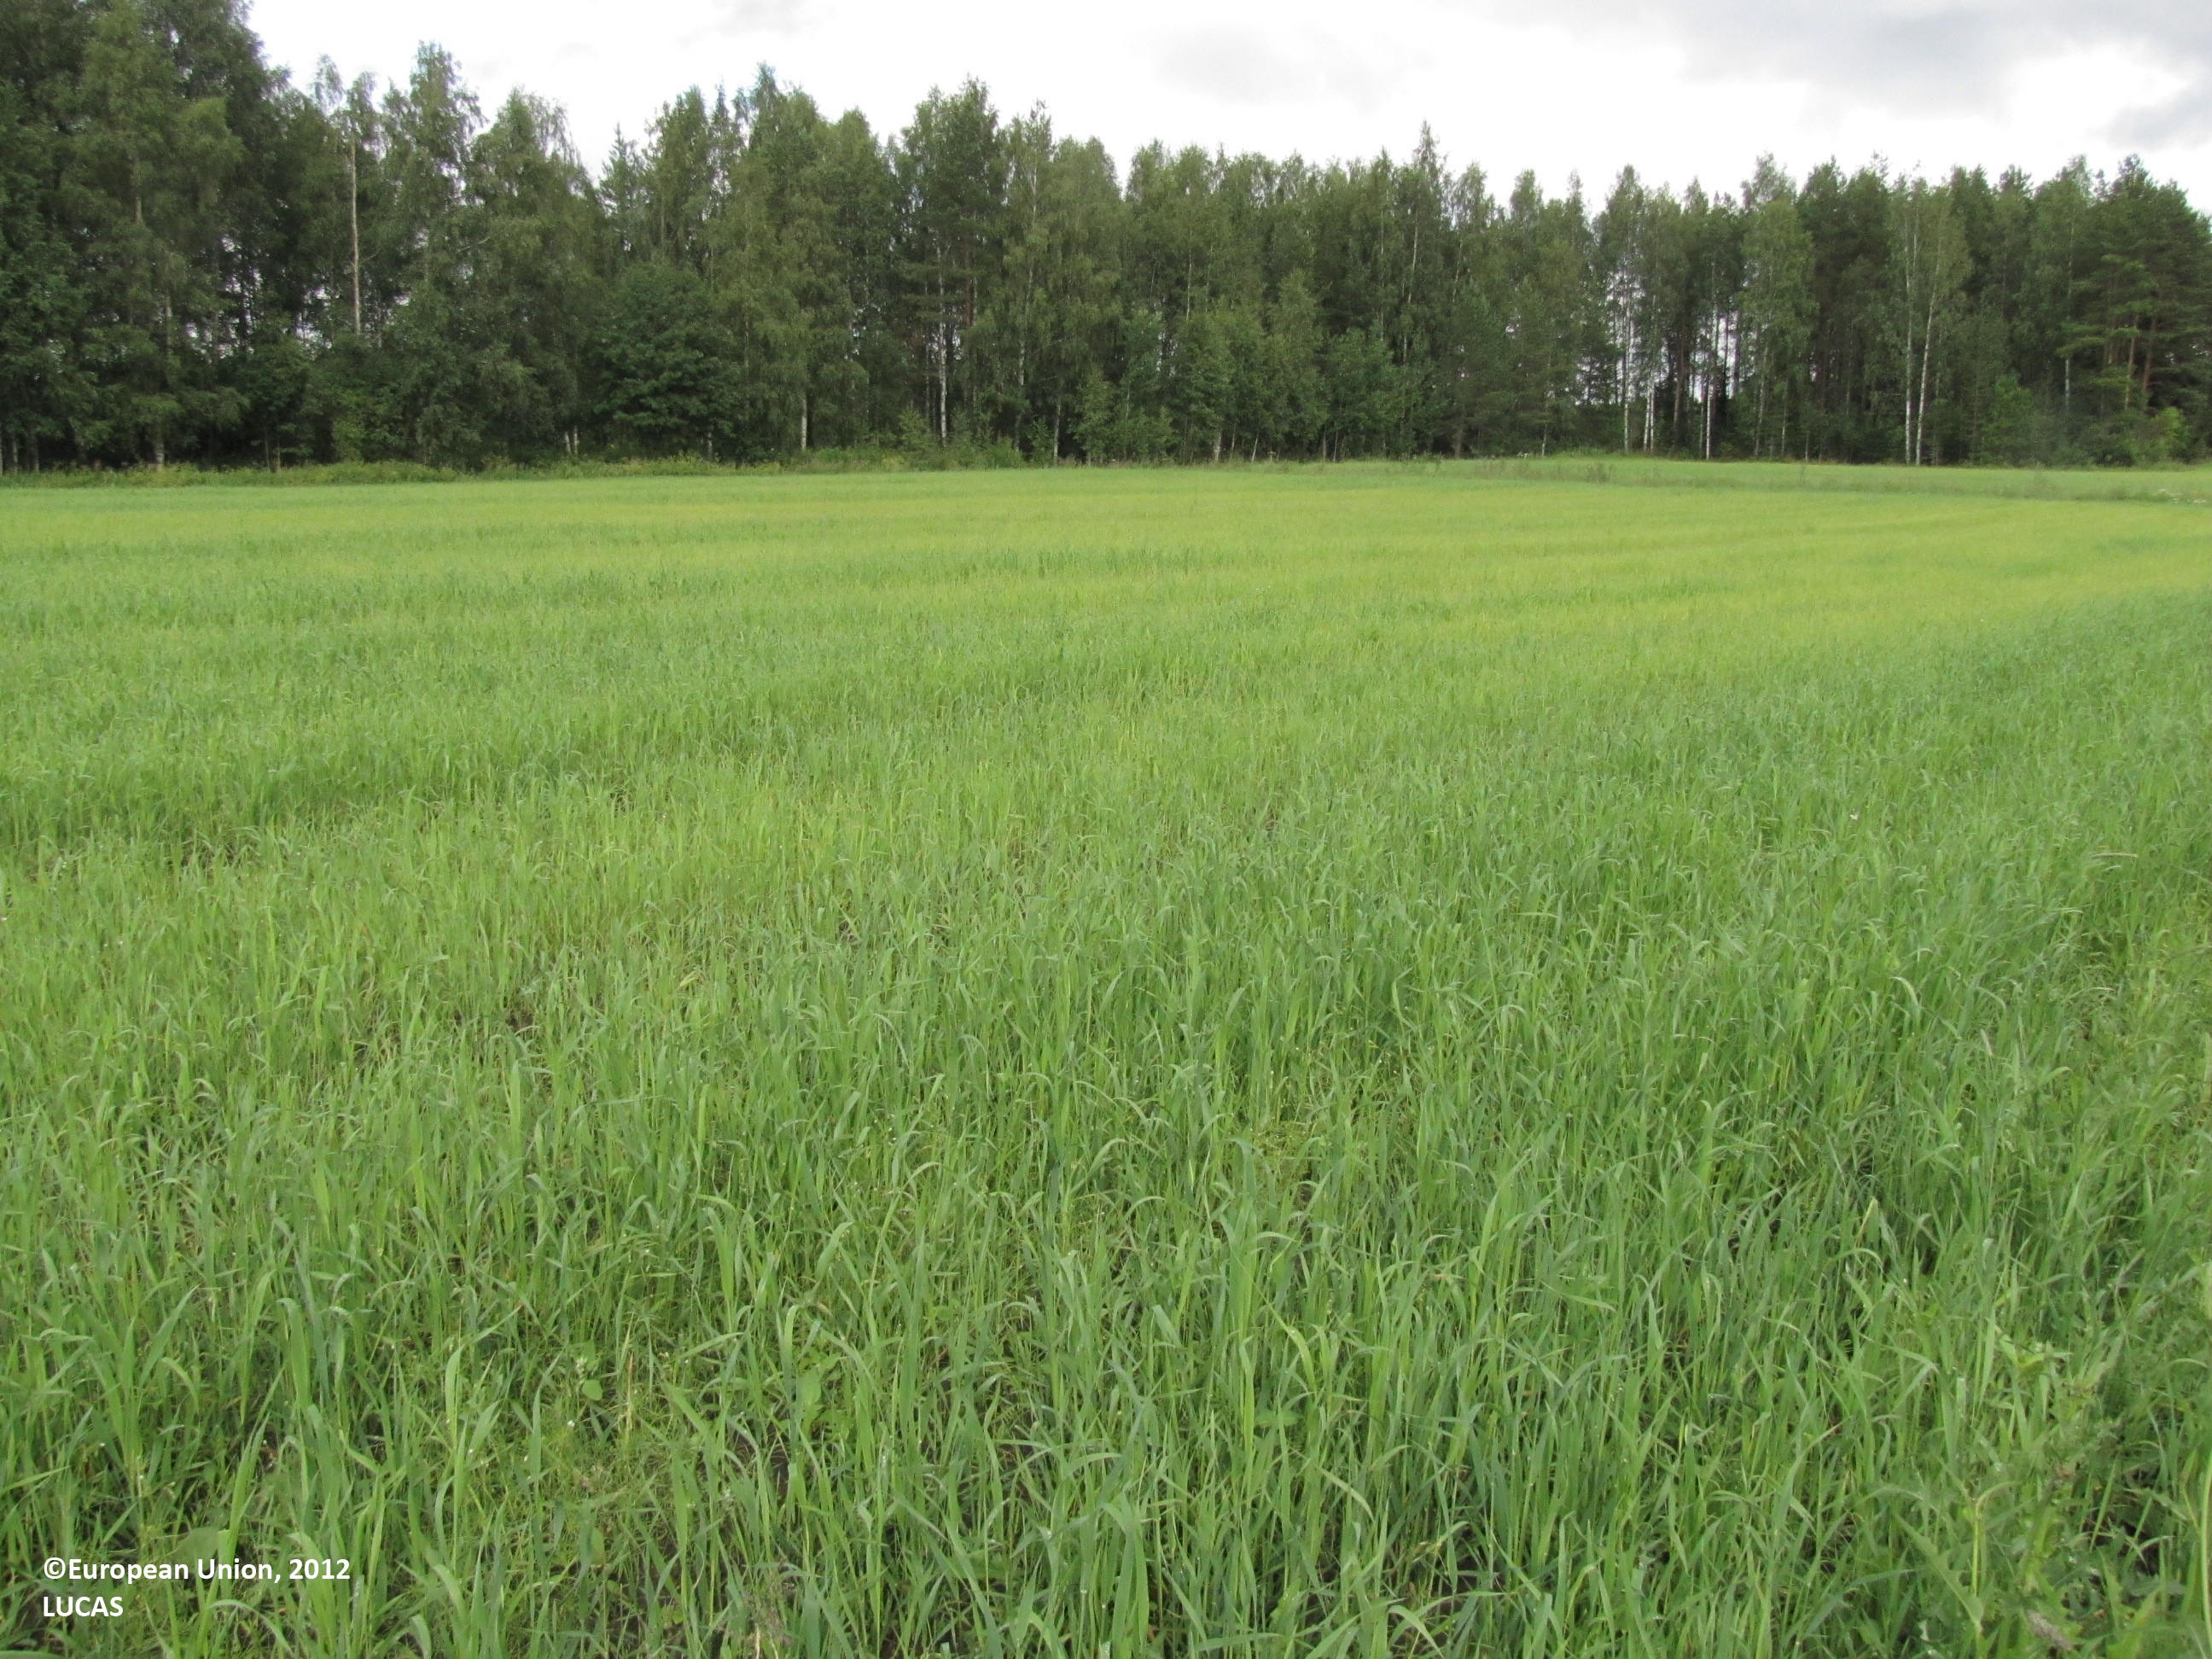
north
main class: Cropland
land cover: Oats
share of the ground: 50 - 75 %
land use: Agriculture (excluding fallow land and kitchen gardens)
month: July
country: FI
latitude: 62.3103
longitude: 23.3221
